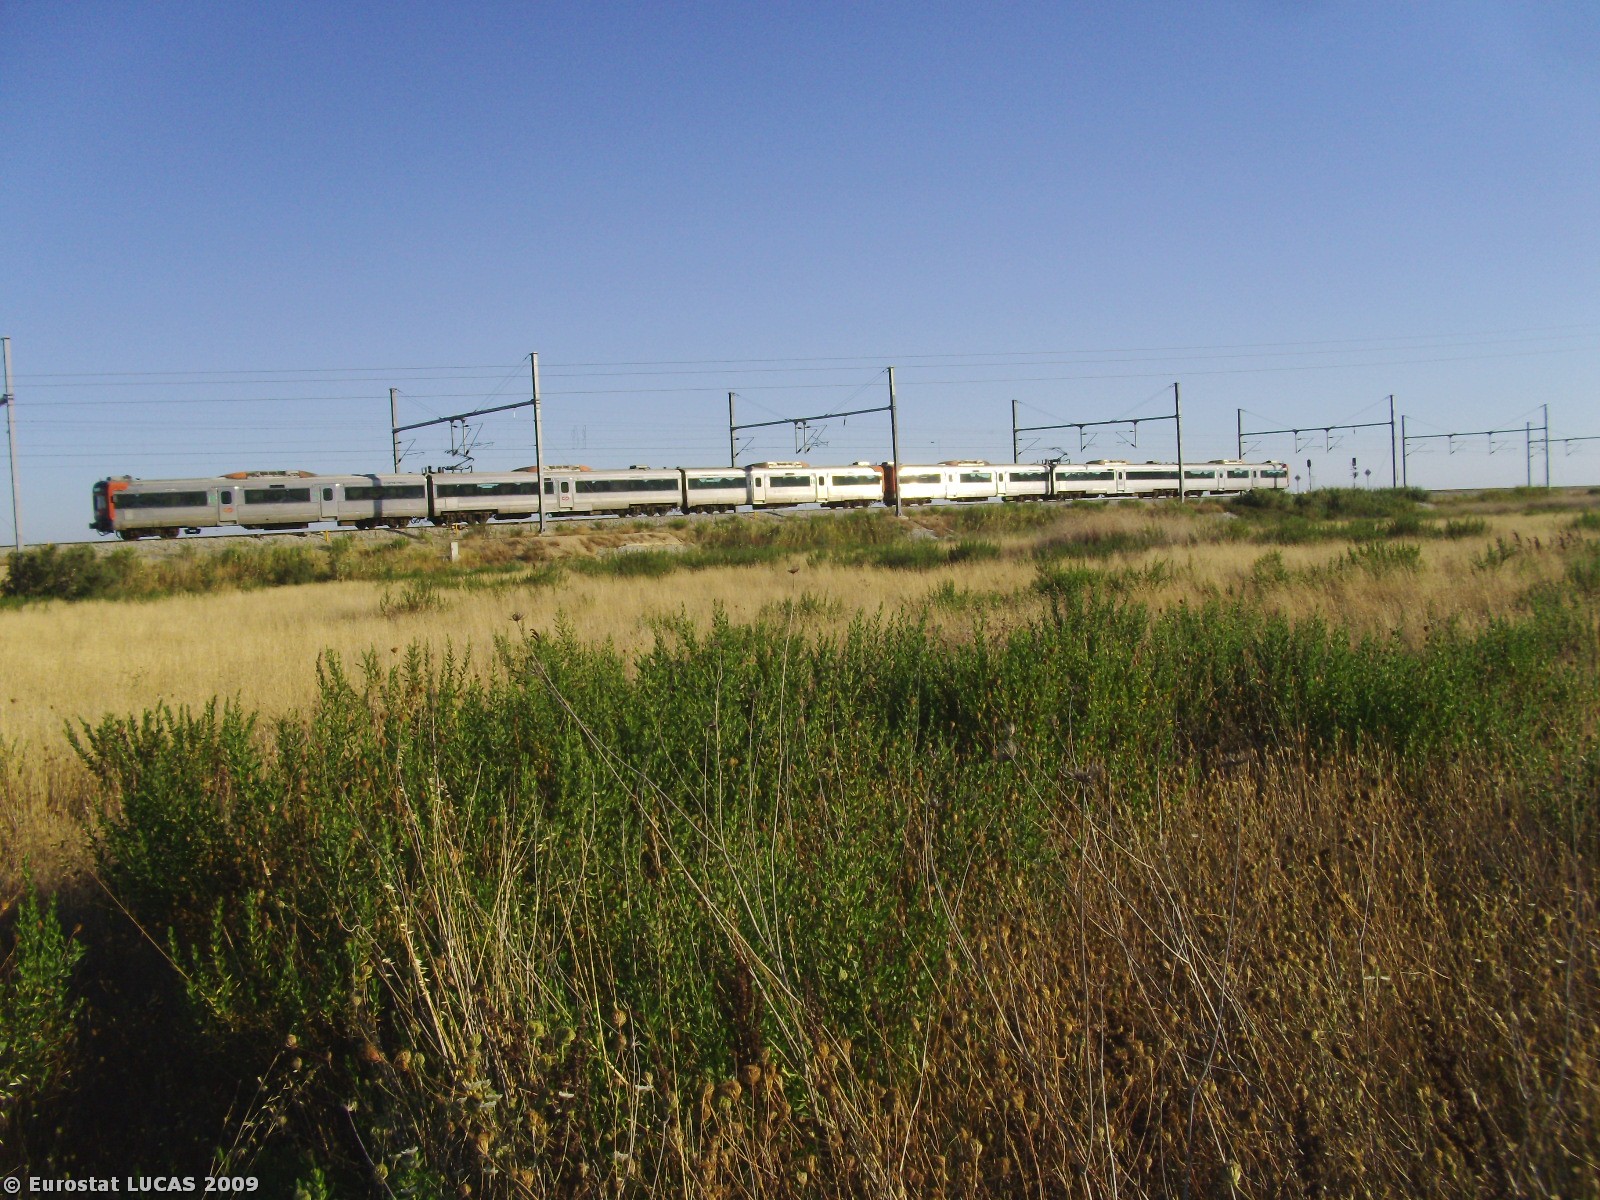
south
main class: Grassland
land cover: Spontaneously vegetated surfaces
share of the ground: > 75 %
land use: Fallow land
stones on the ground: 10 - 25 %
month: July
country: PT
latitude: 39.0640
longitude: -8.8780
